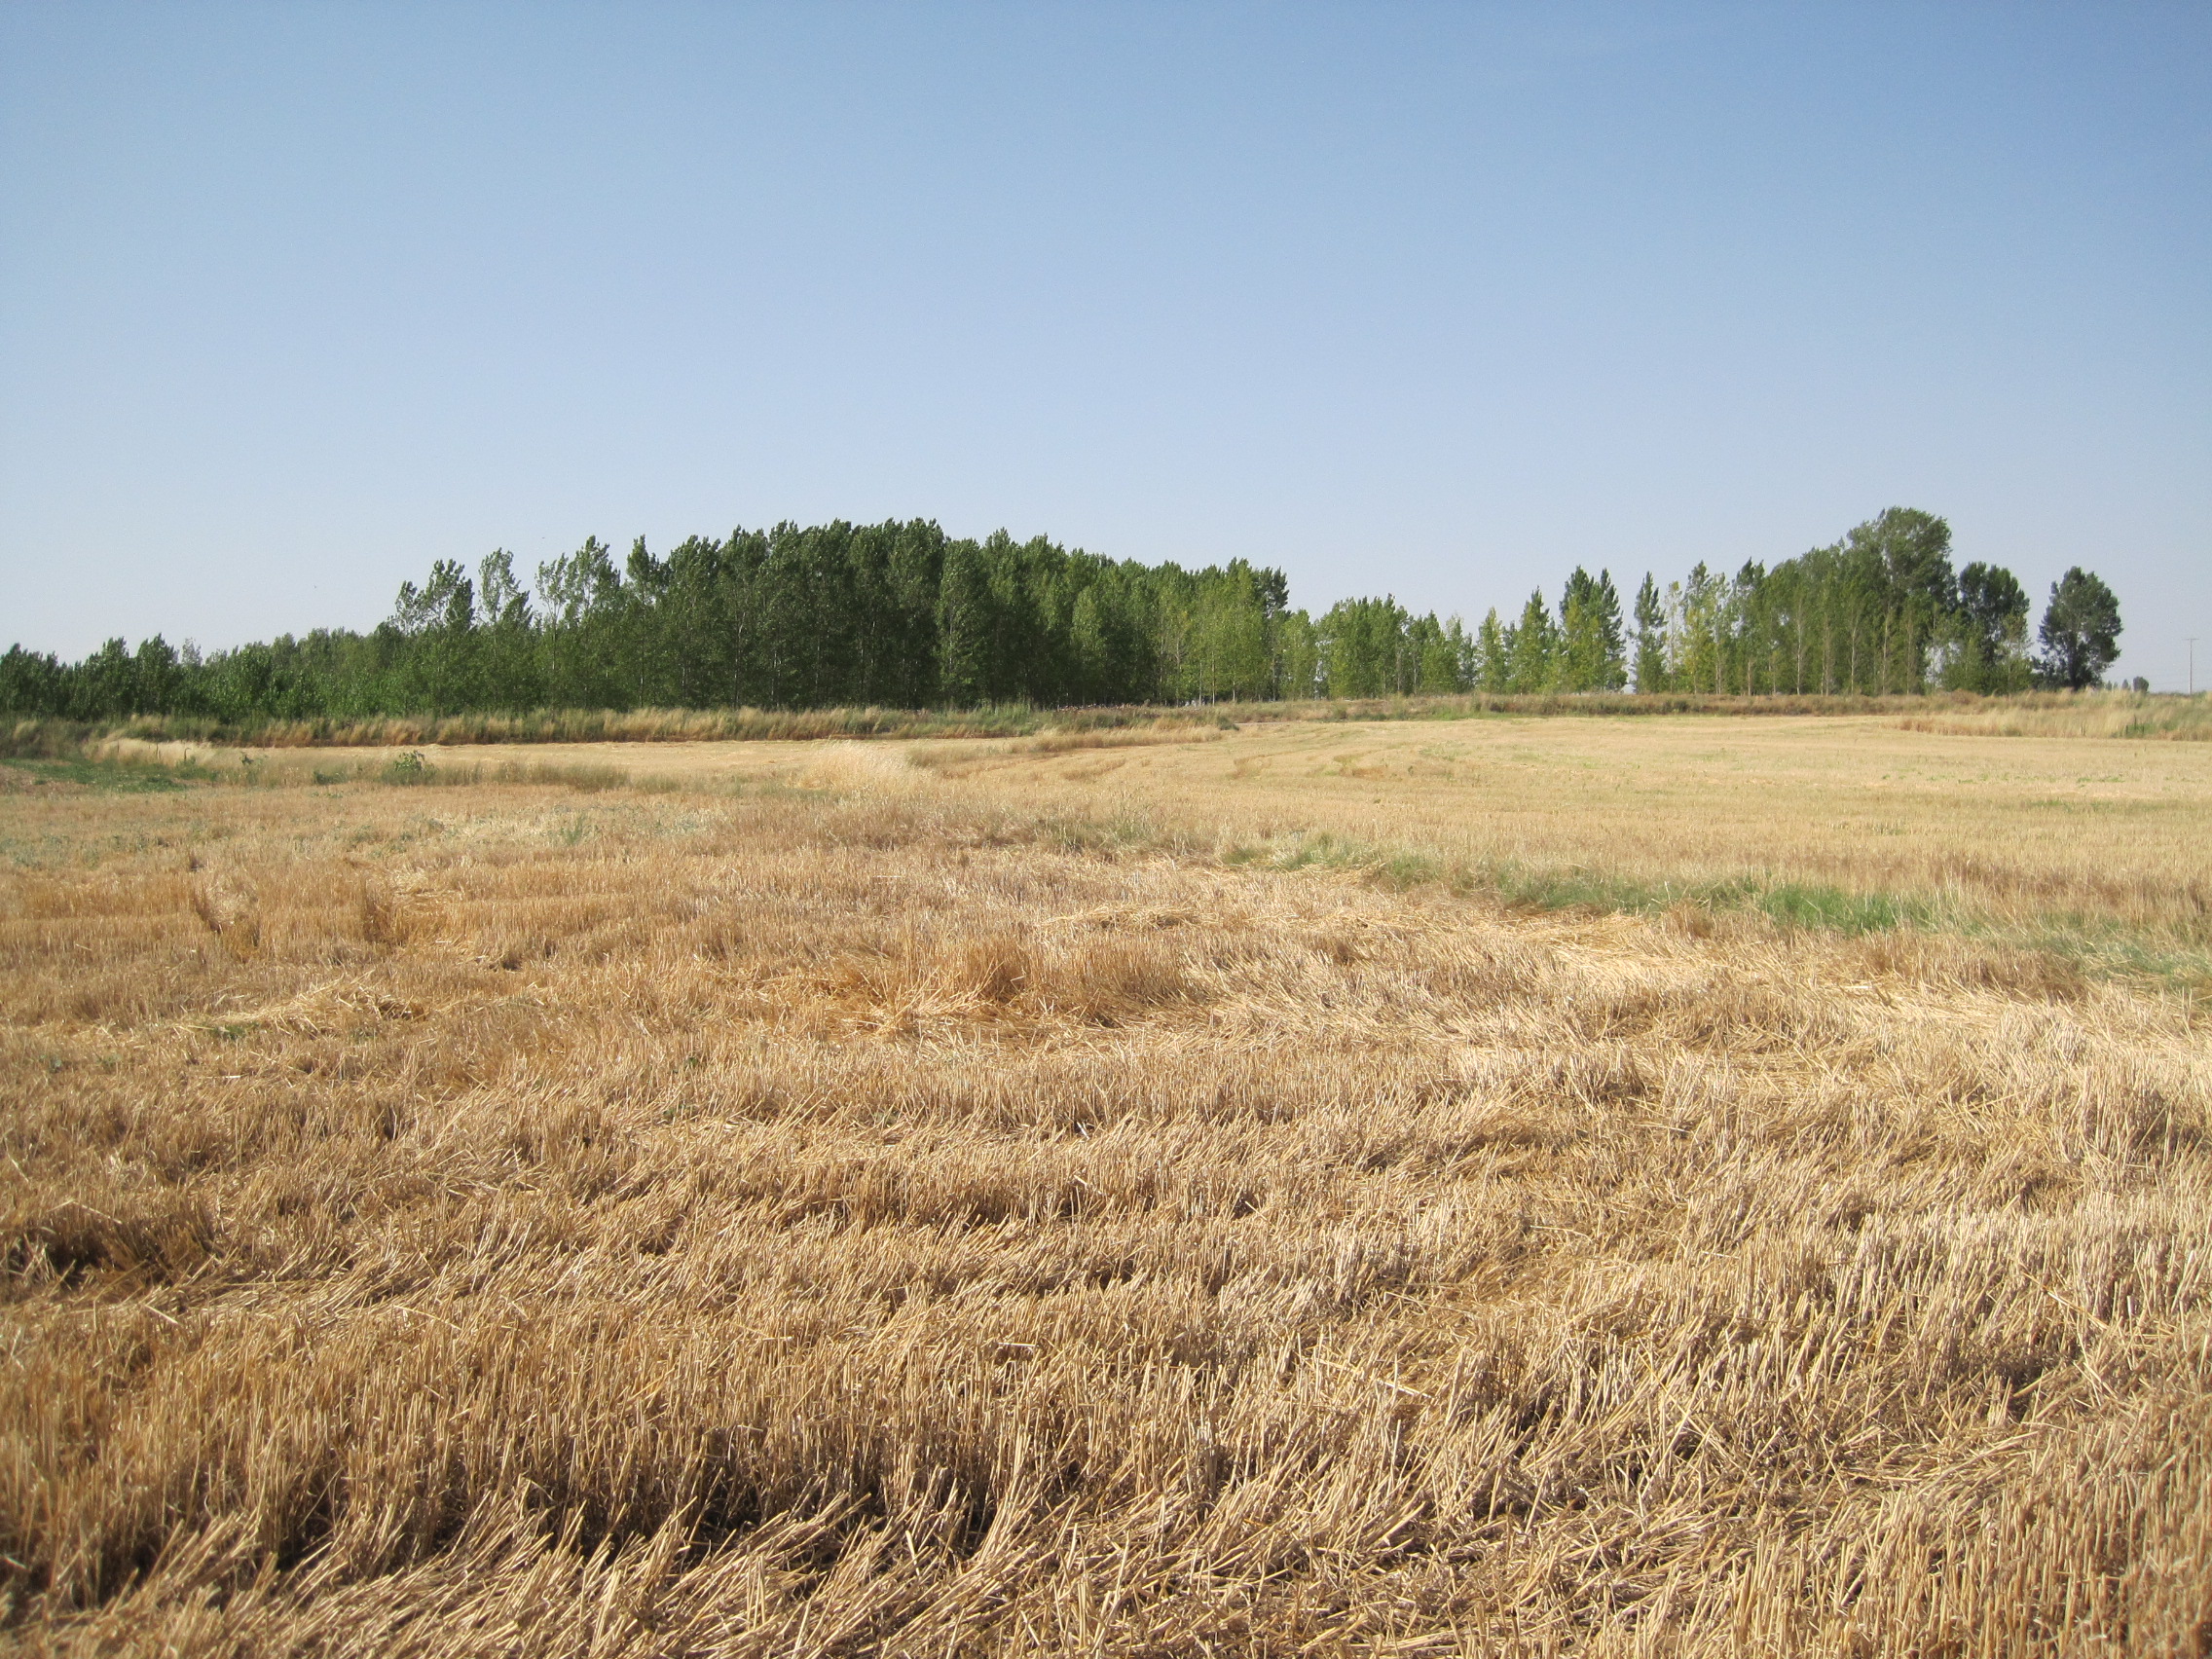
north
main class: Cropland
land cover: Common wheat
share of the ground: < 10 %
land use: Agriculture (excluding fallow land and kitchen gardens)
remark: Harvested field
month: July
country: ES
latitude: 41.7228
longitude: -5.5318
